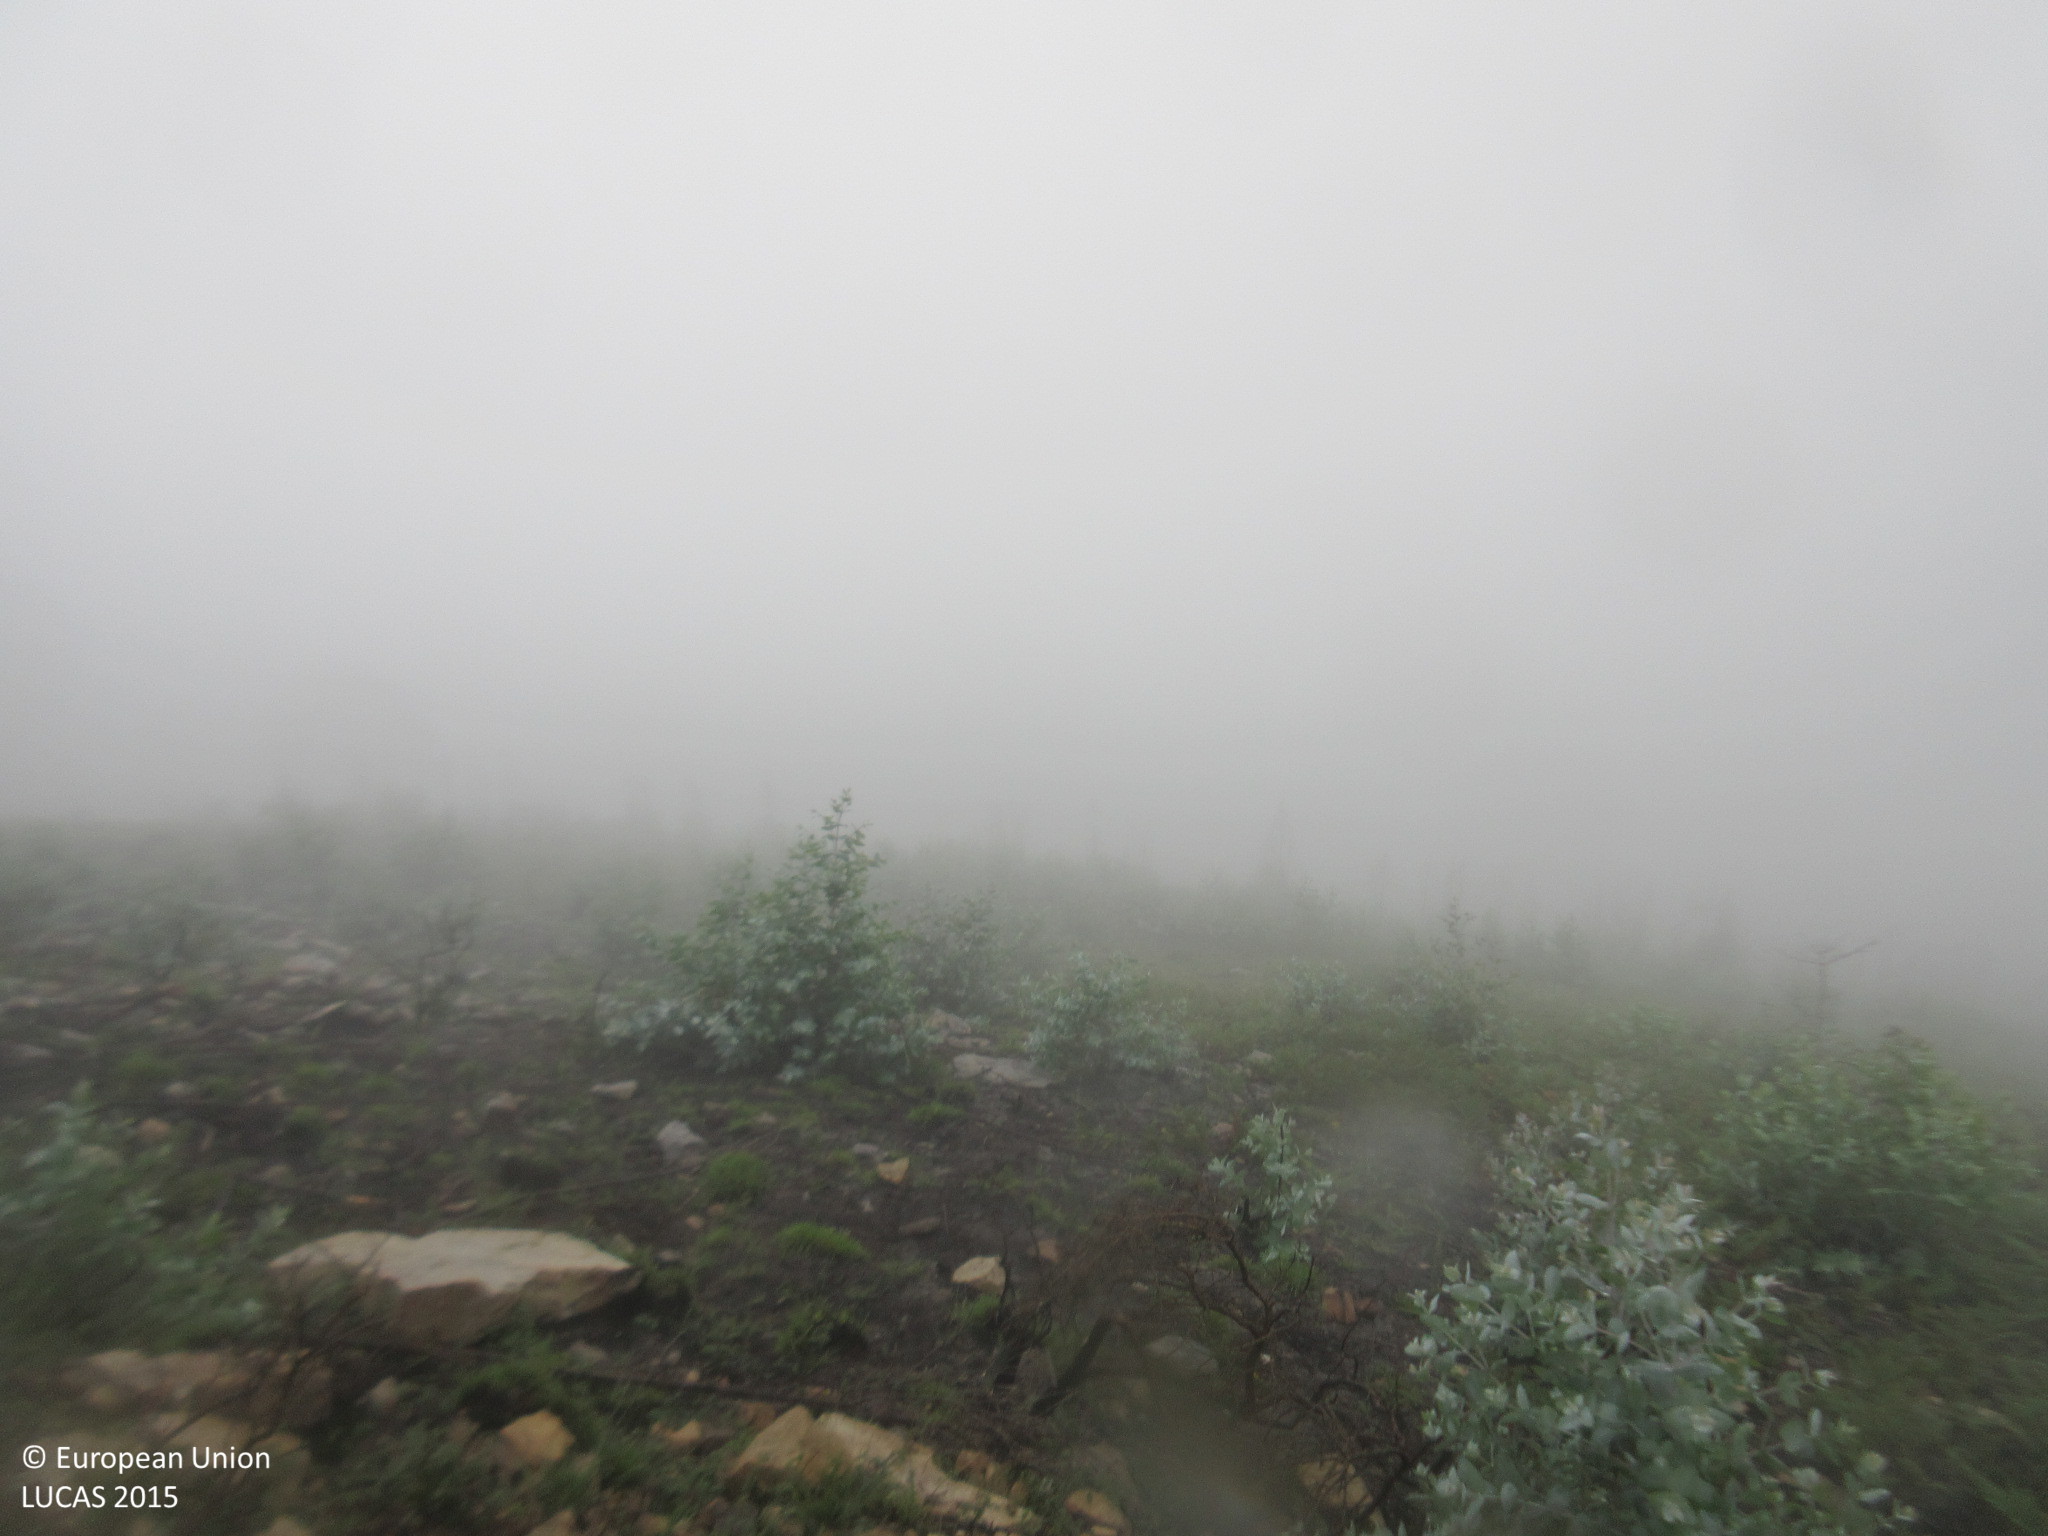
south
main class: Woodland
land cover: Broadleaved woodland
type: exotic forest
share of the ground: 25 - 50 %
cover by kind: shrubs 55 %, broadleaved forest trees 45 %
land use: Forestry
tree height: < 5 m
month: July
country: ES
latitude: 43.2801
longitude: -3.9124
